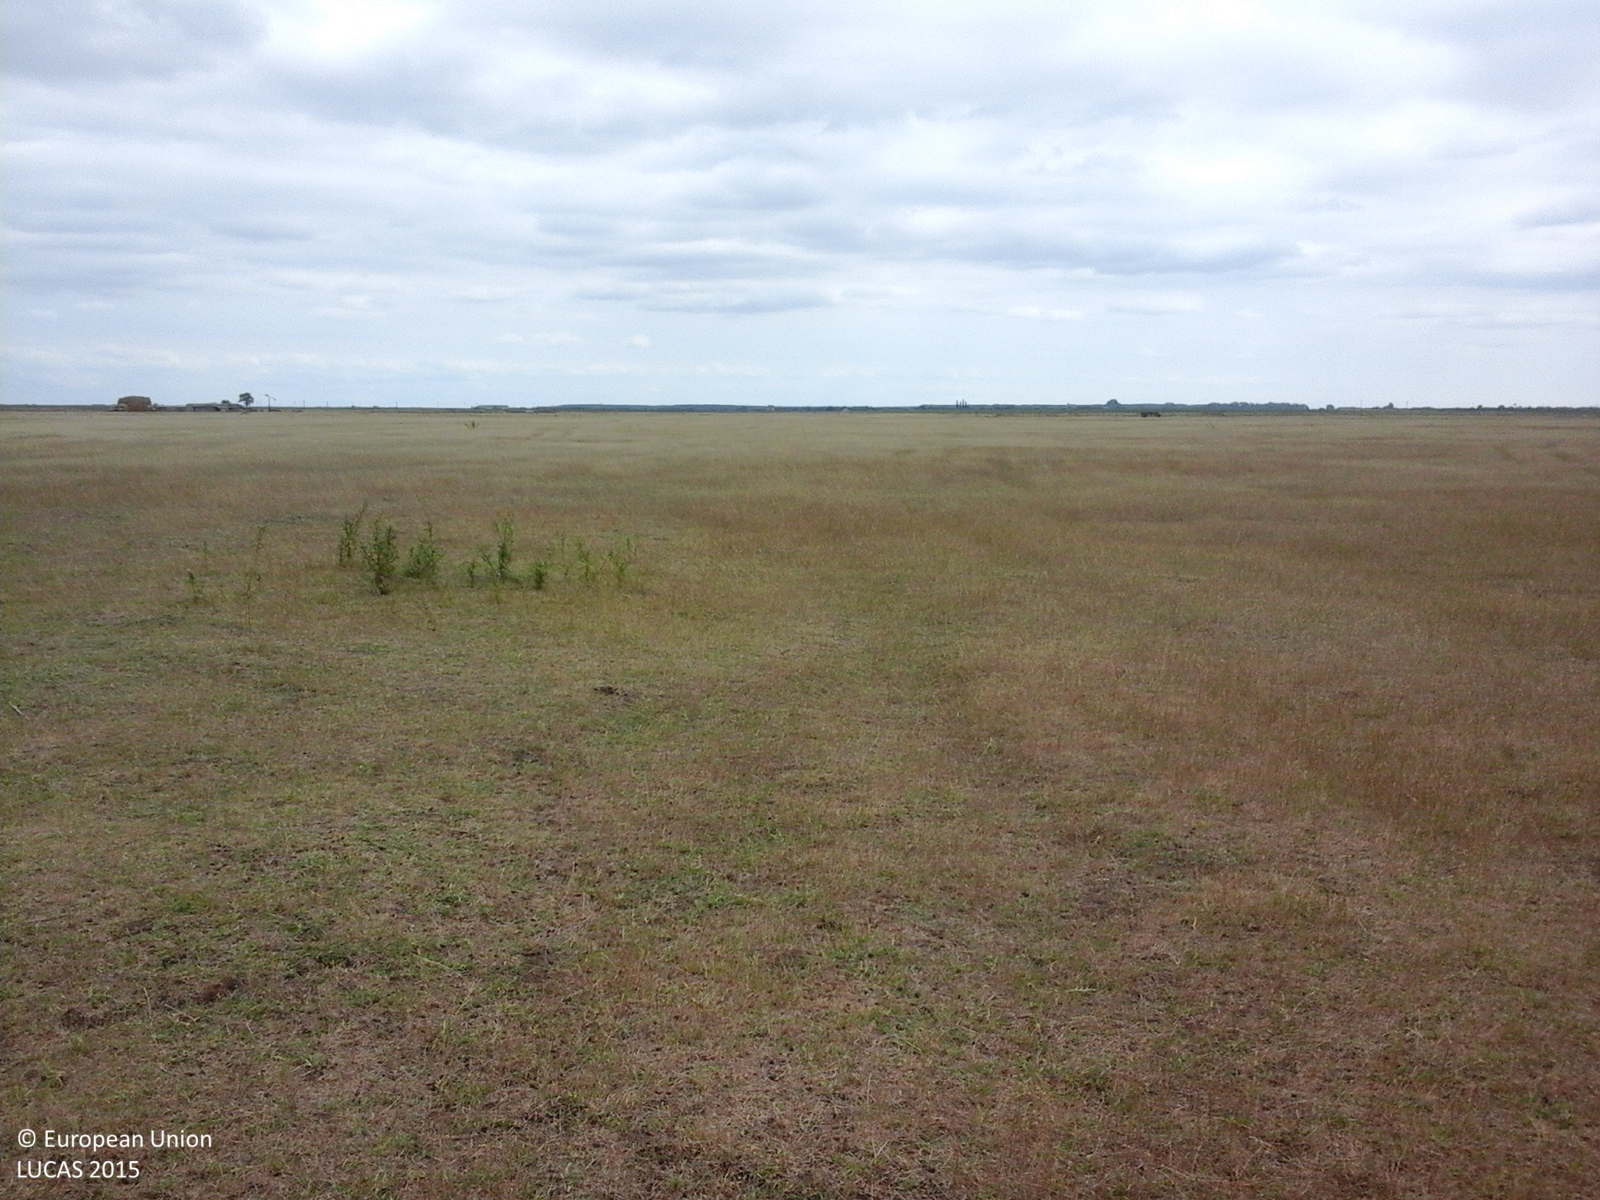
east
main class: Grassland
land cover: Grassland without tree/shrub cover
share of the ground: > 75 %
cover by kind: herbaceous plants 100 %
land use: Agriculture (excluding fallow land and kitchen gardens)
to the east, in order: Grassland without tree/shrub cover
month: August
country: RO
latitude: 45.5125
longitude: 20.9708
